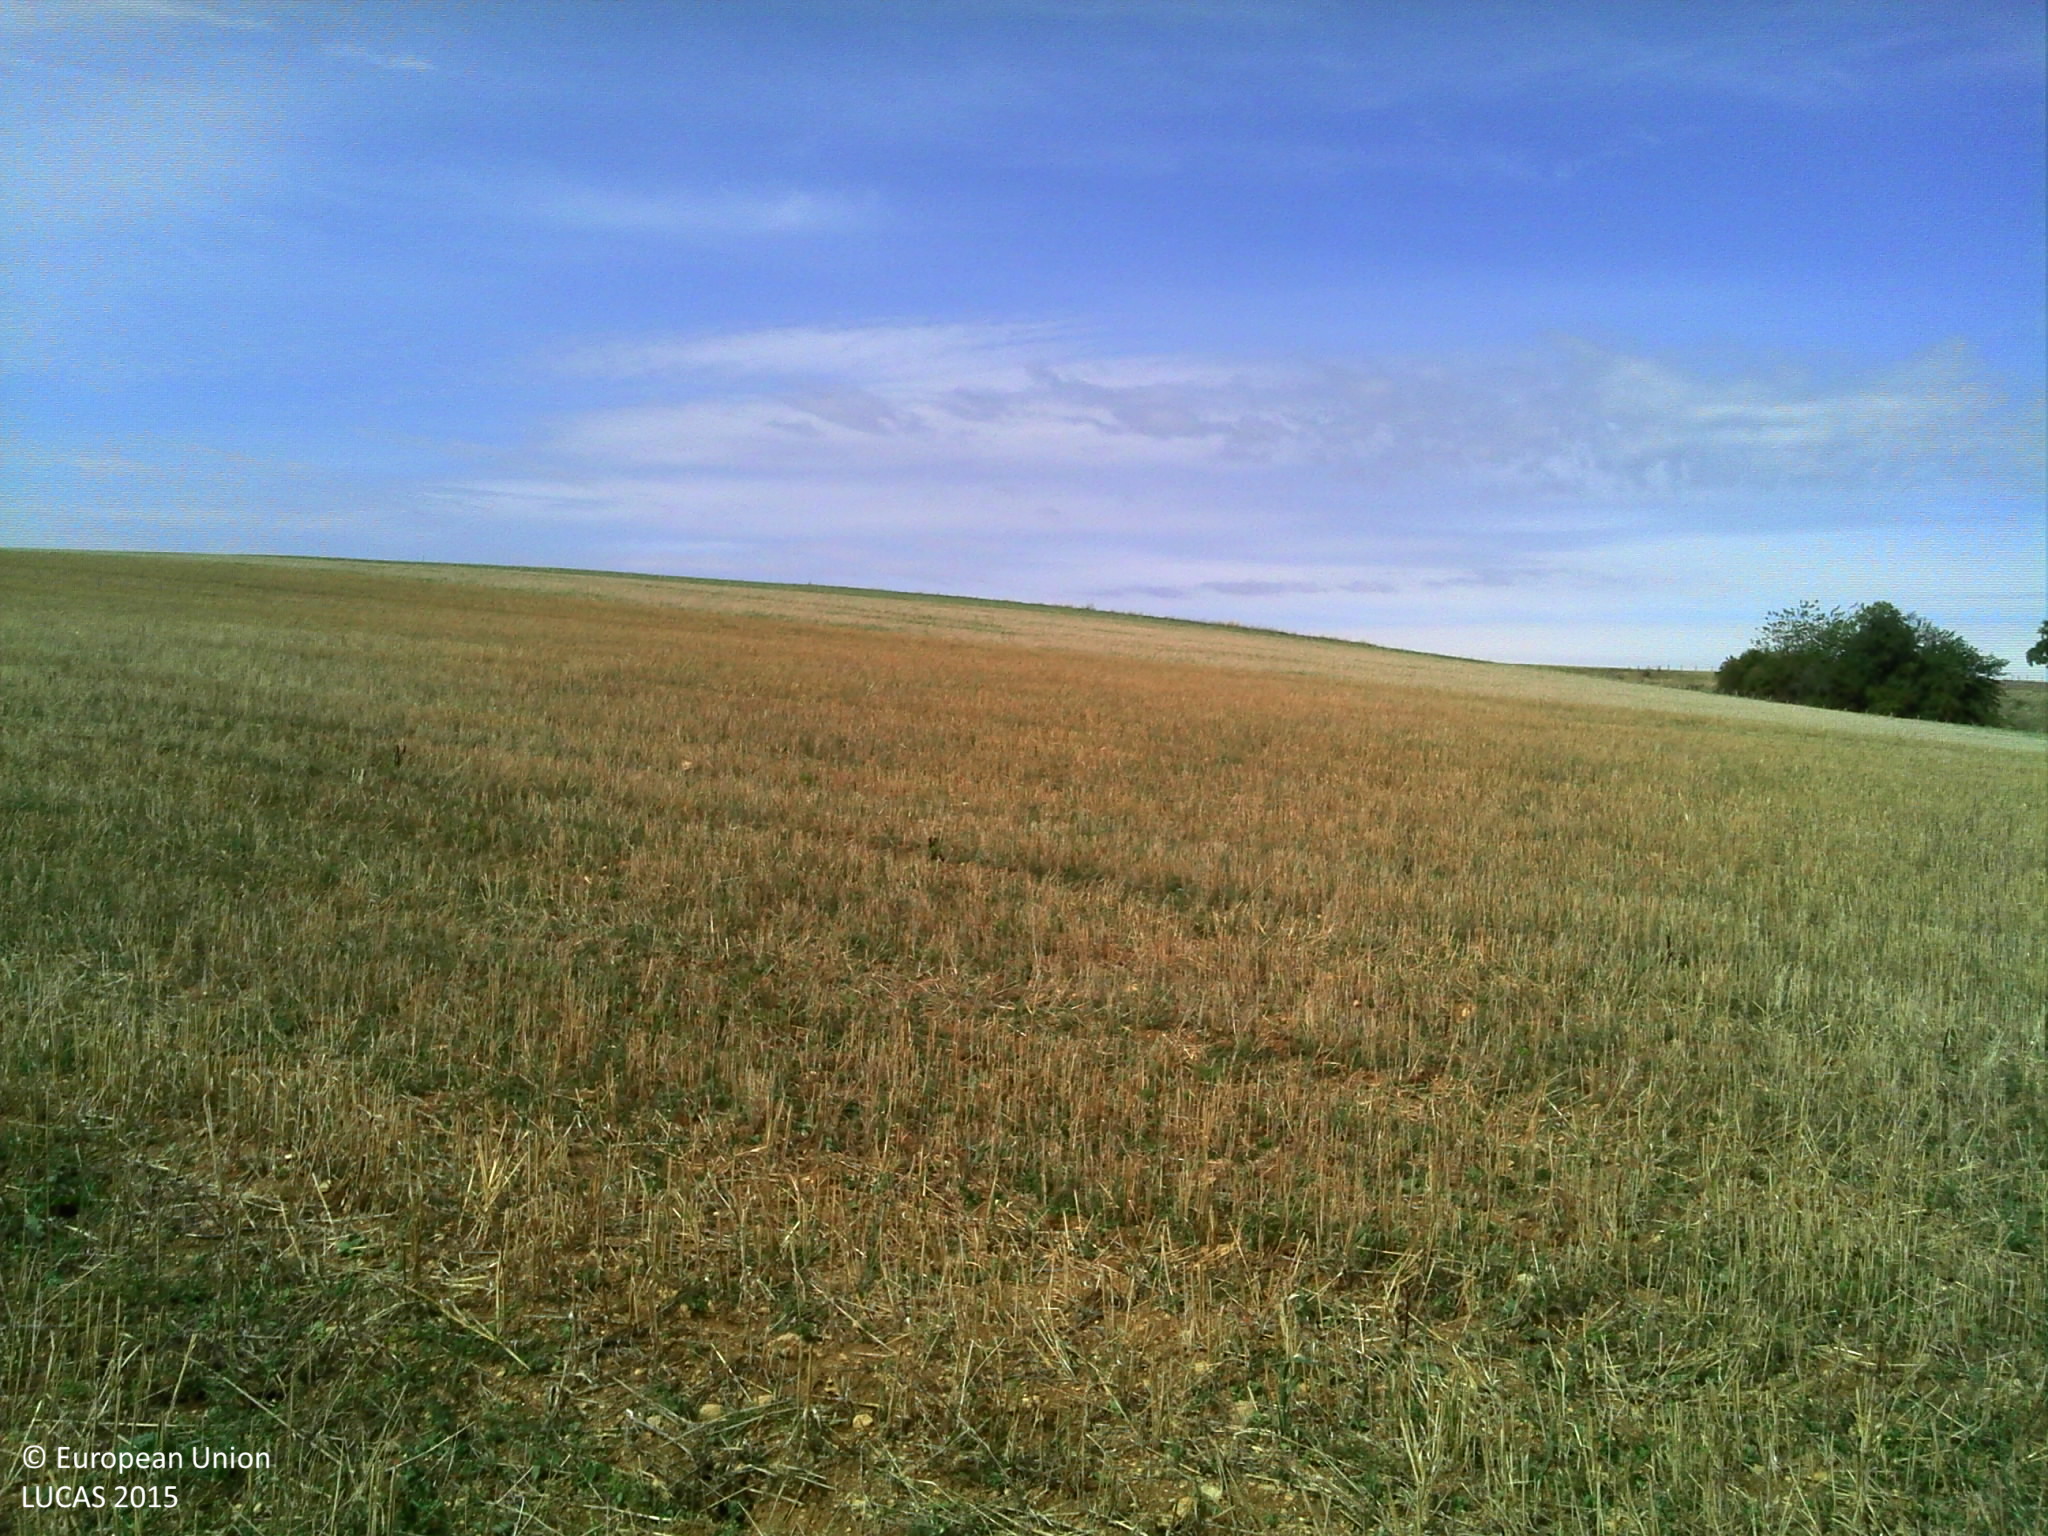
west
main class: Cropland
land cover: Oats
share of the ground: > 75 %
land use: Agriculture (excluding fallow land and kitchen gardens)
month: August
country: FR
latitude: 47.6572
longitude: 4.9534
